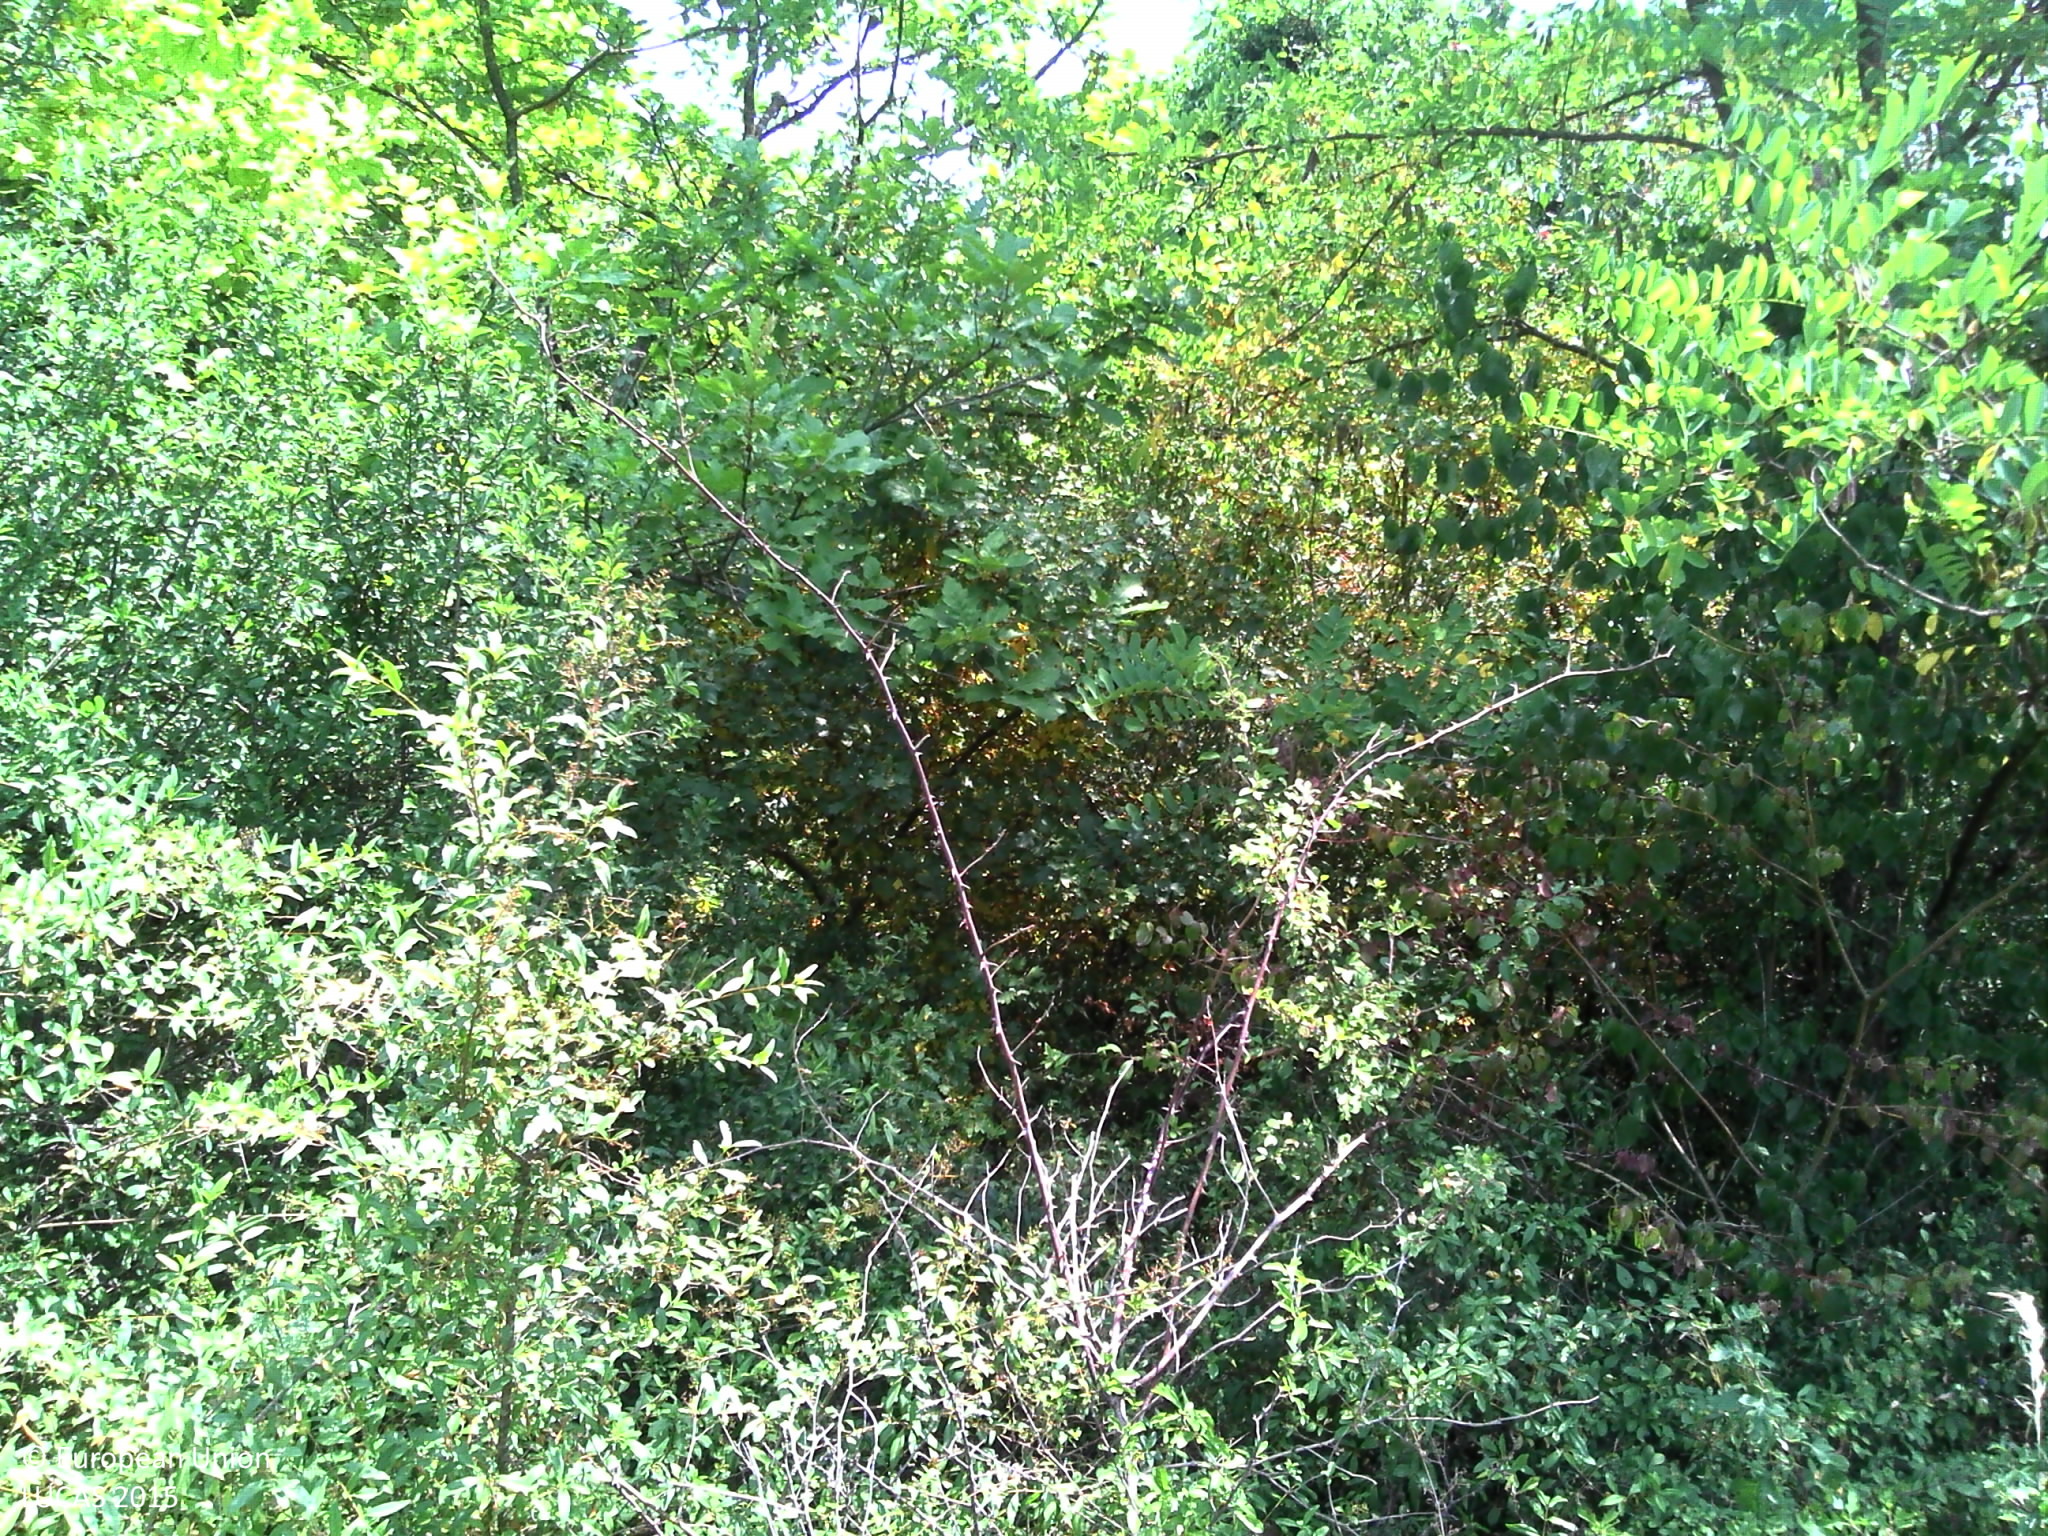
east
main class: Woodland
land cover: Broadleaved woodland
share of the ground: > 75 %
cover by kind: broadleaved forest trees 90 %, herbaceous plants 10 %
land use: Forestry
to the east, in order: Broadleaved woodland; Durum wheat; Abandoned hedges; Grassland without tree/shrub cover; Abandoned hedges; Grass margins; Tracks; Grass margins; Abandoned hedges; Other bare soil
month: July
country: FR
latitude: 45.8028
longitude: 5.4363
